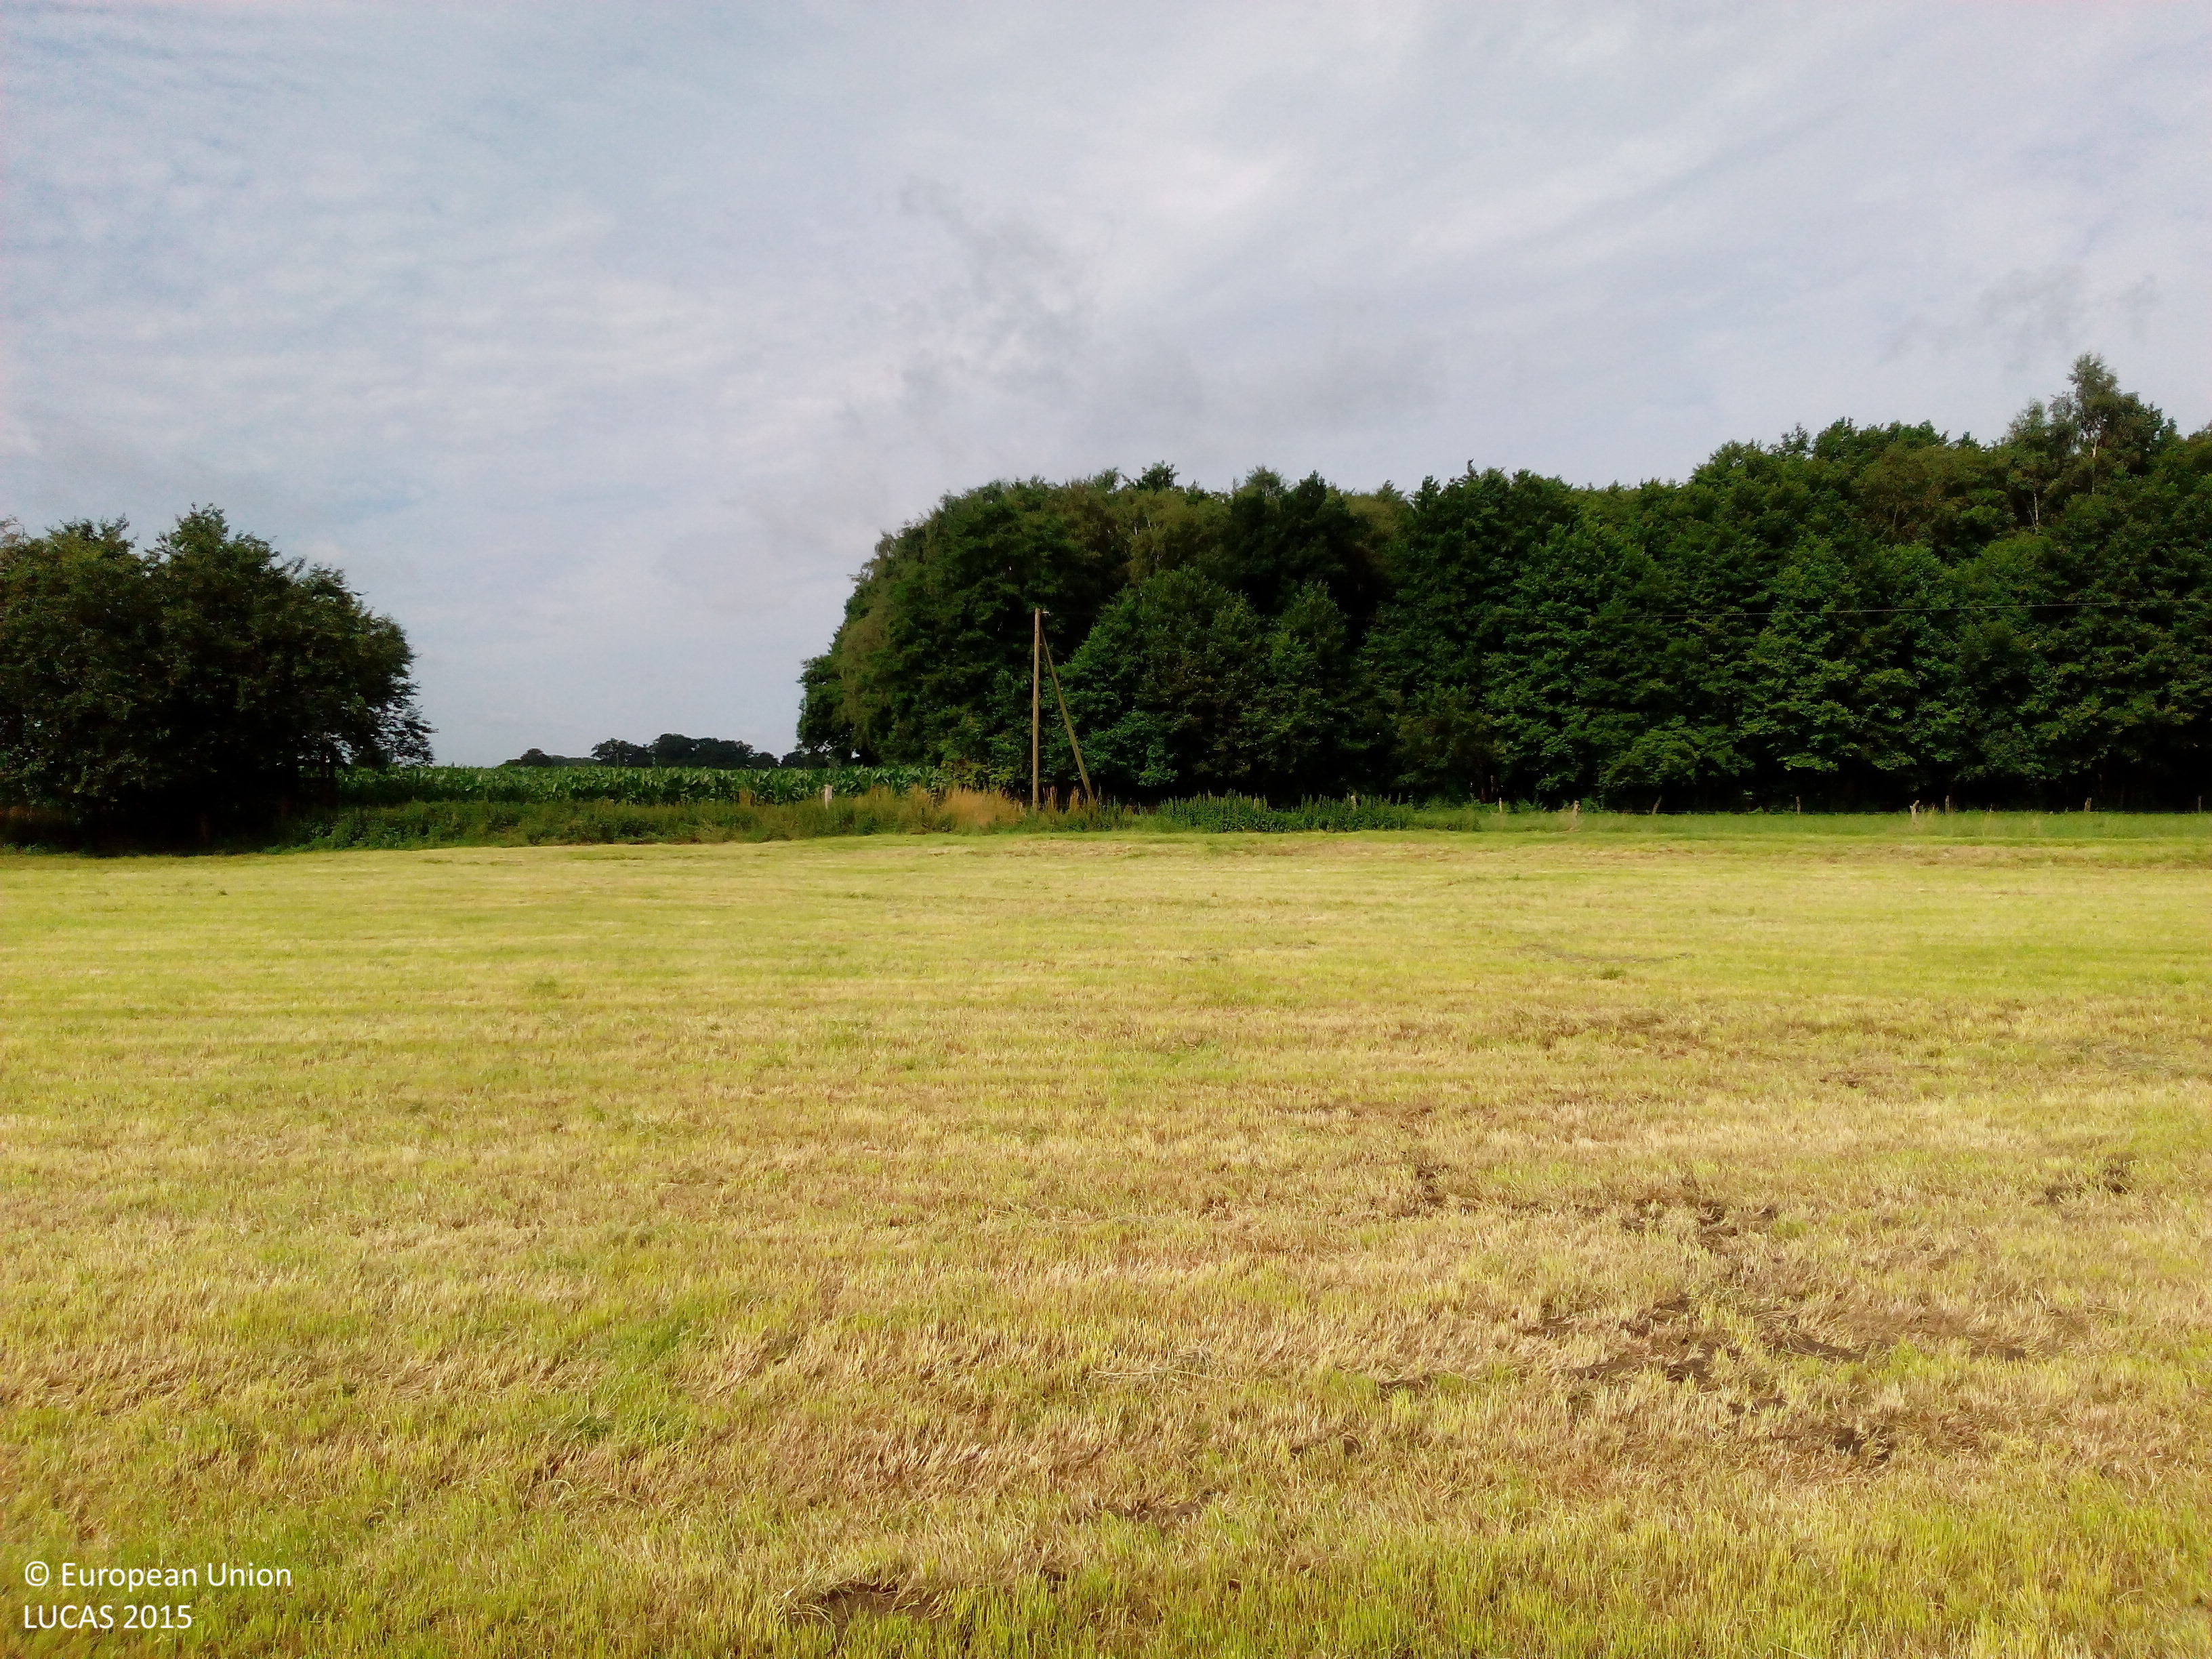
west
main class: Grassland
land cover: Grassland without tree/shrub cover
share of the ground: > 75 %
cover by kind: herbaceous plants 100 %
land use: Agriculture (excluding fallow land and kitchen gardens)
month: July
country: DE
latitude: 52.5945
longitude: 8.0076
